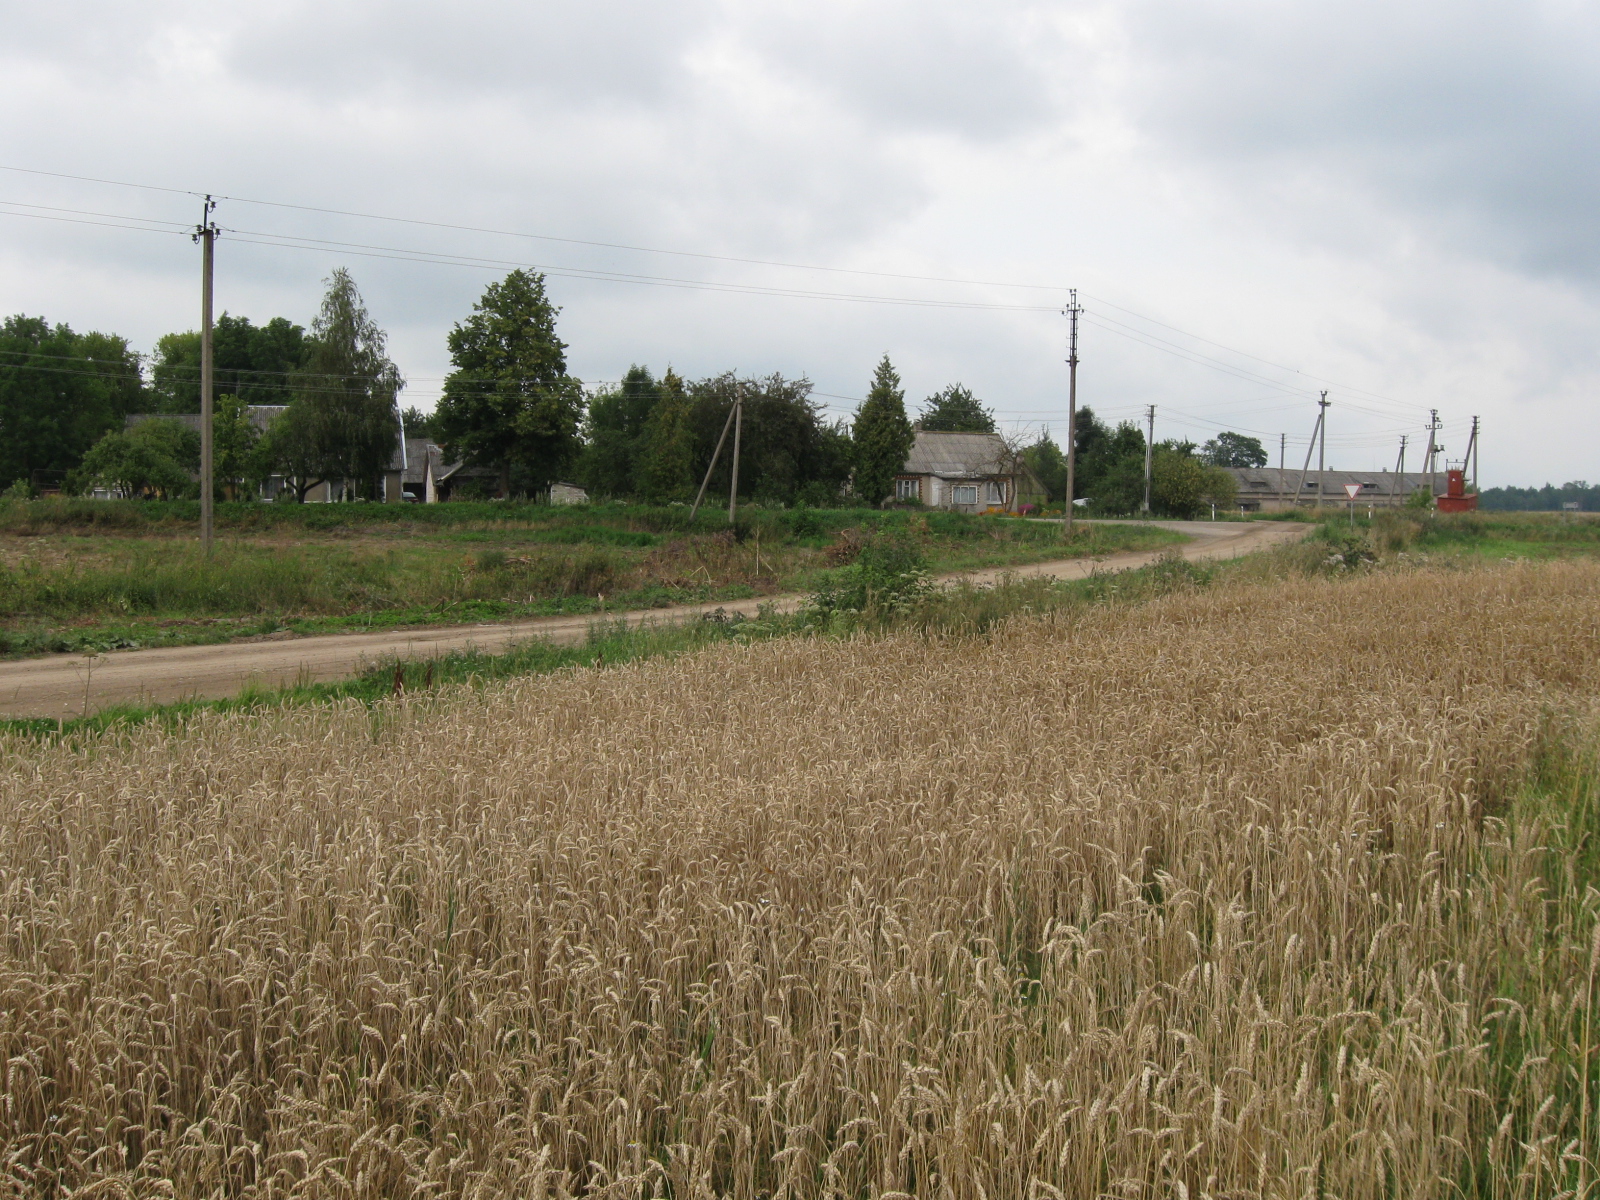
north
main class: Cropland
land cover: Common wheat
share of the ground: > 75 %
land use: Agriculture (excluding fallow land and kitchen gardens)
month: August
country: LT
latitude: 54.6465
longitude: 23.5177
